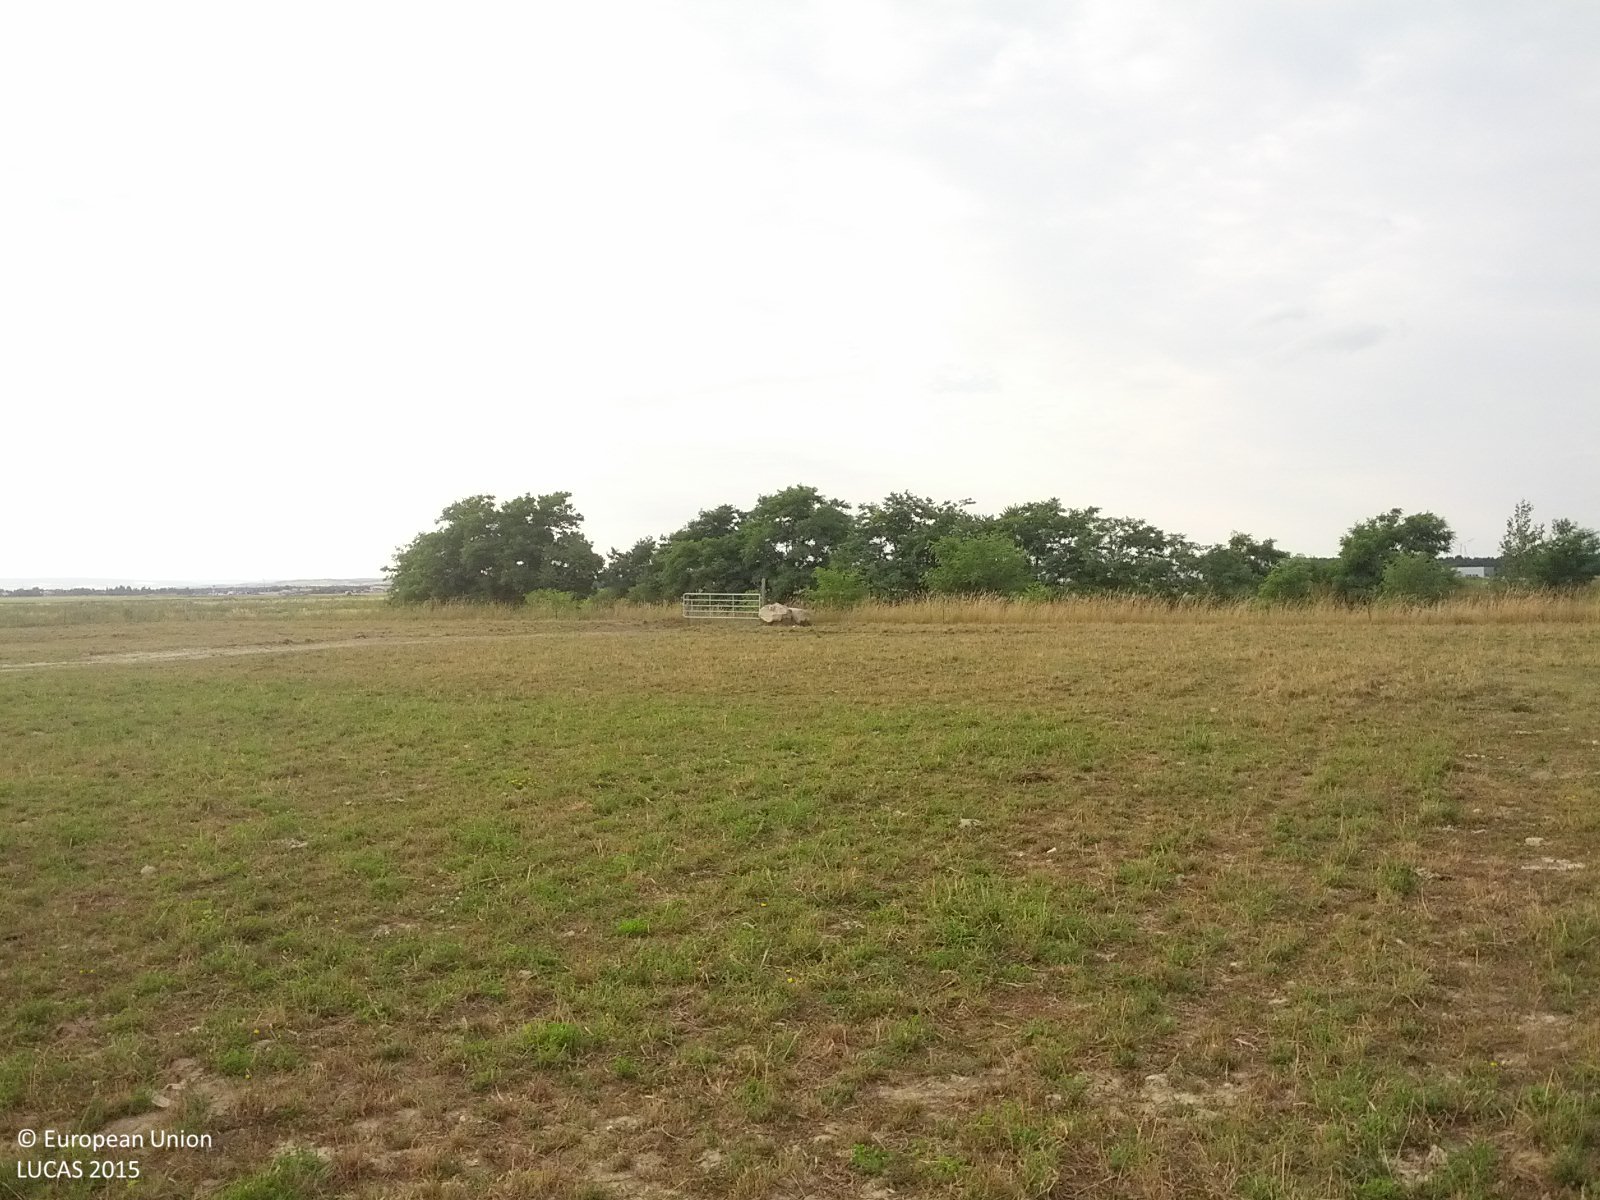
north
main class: Grassland
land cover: Grassland without tree/shrub cover
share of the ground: > 75 %
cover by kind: herbaceous plants 75 %, consolidated bare surface 25 %
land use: Agriculture (excluding fallow land and kitchen gardens)
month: June
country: AT
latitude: 48.2951
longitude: 16.6246
